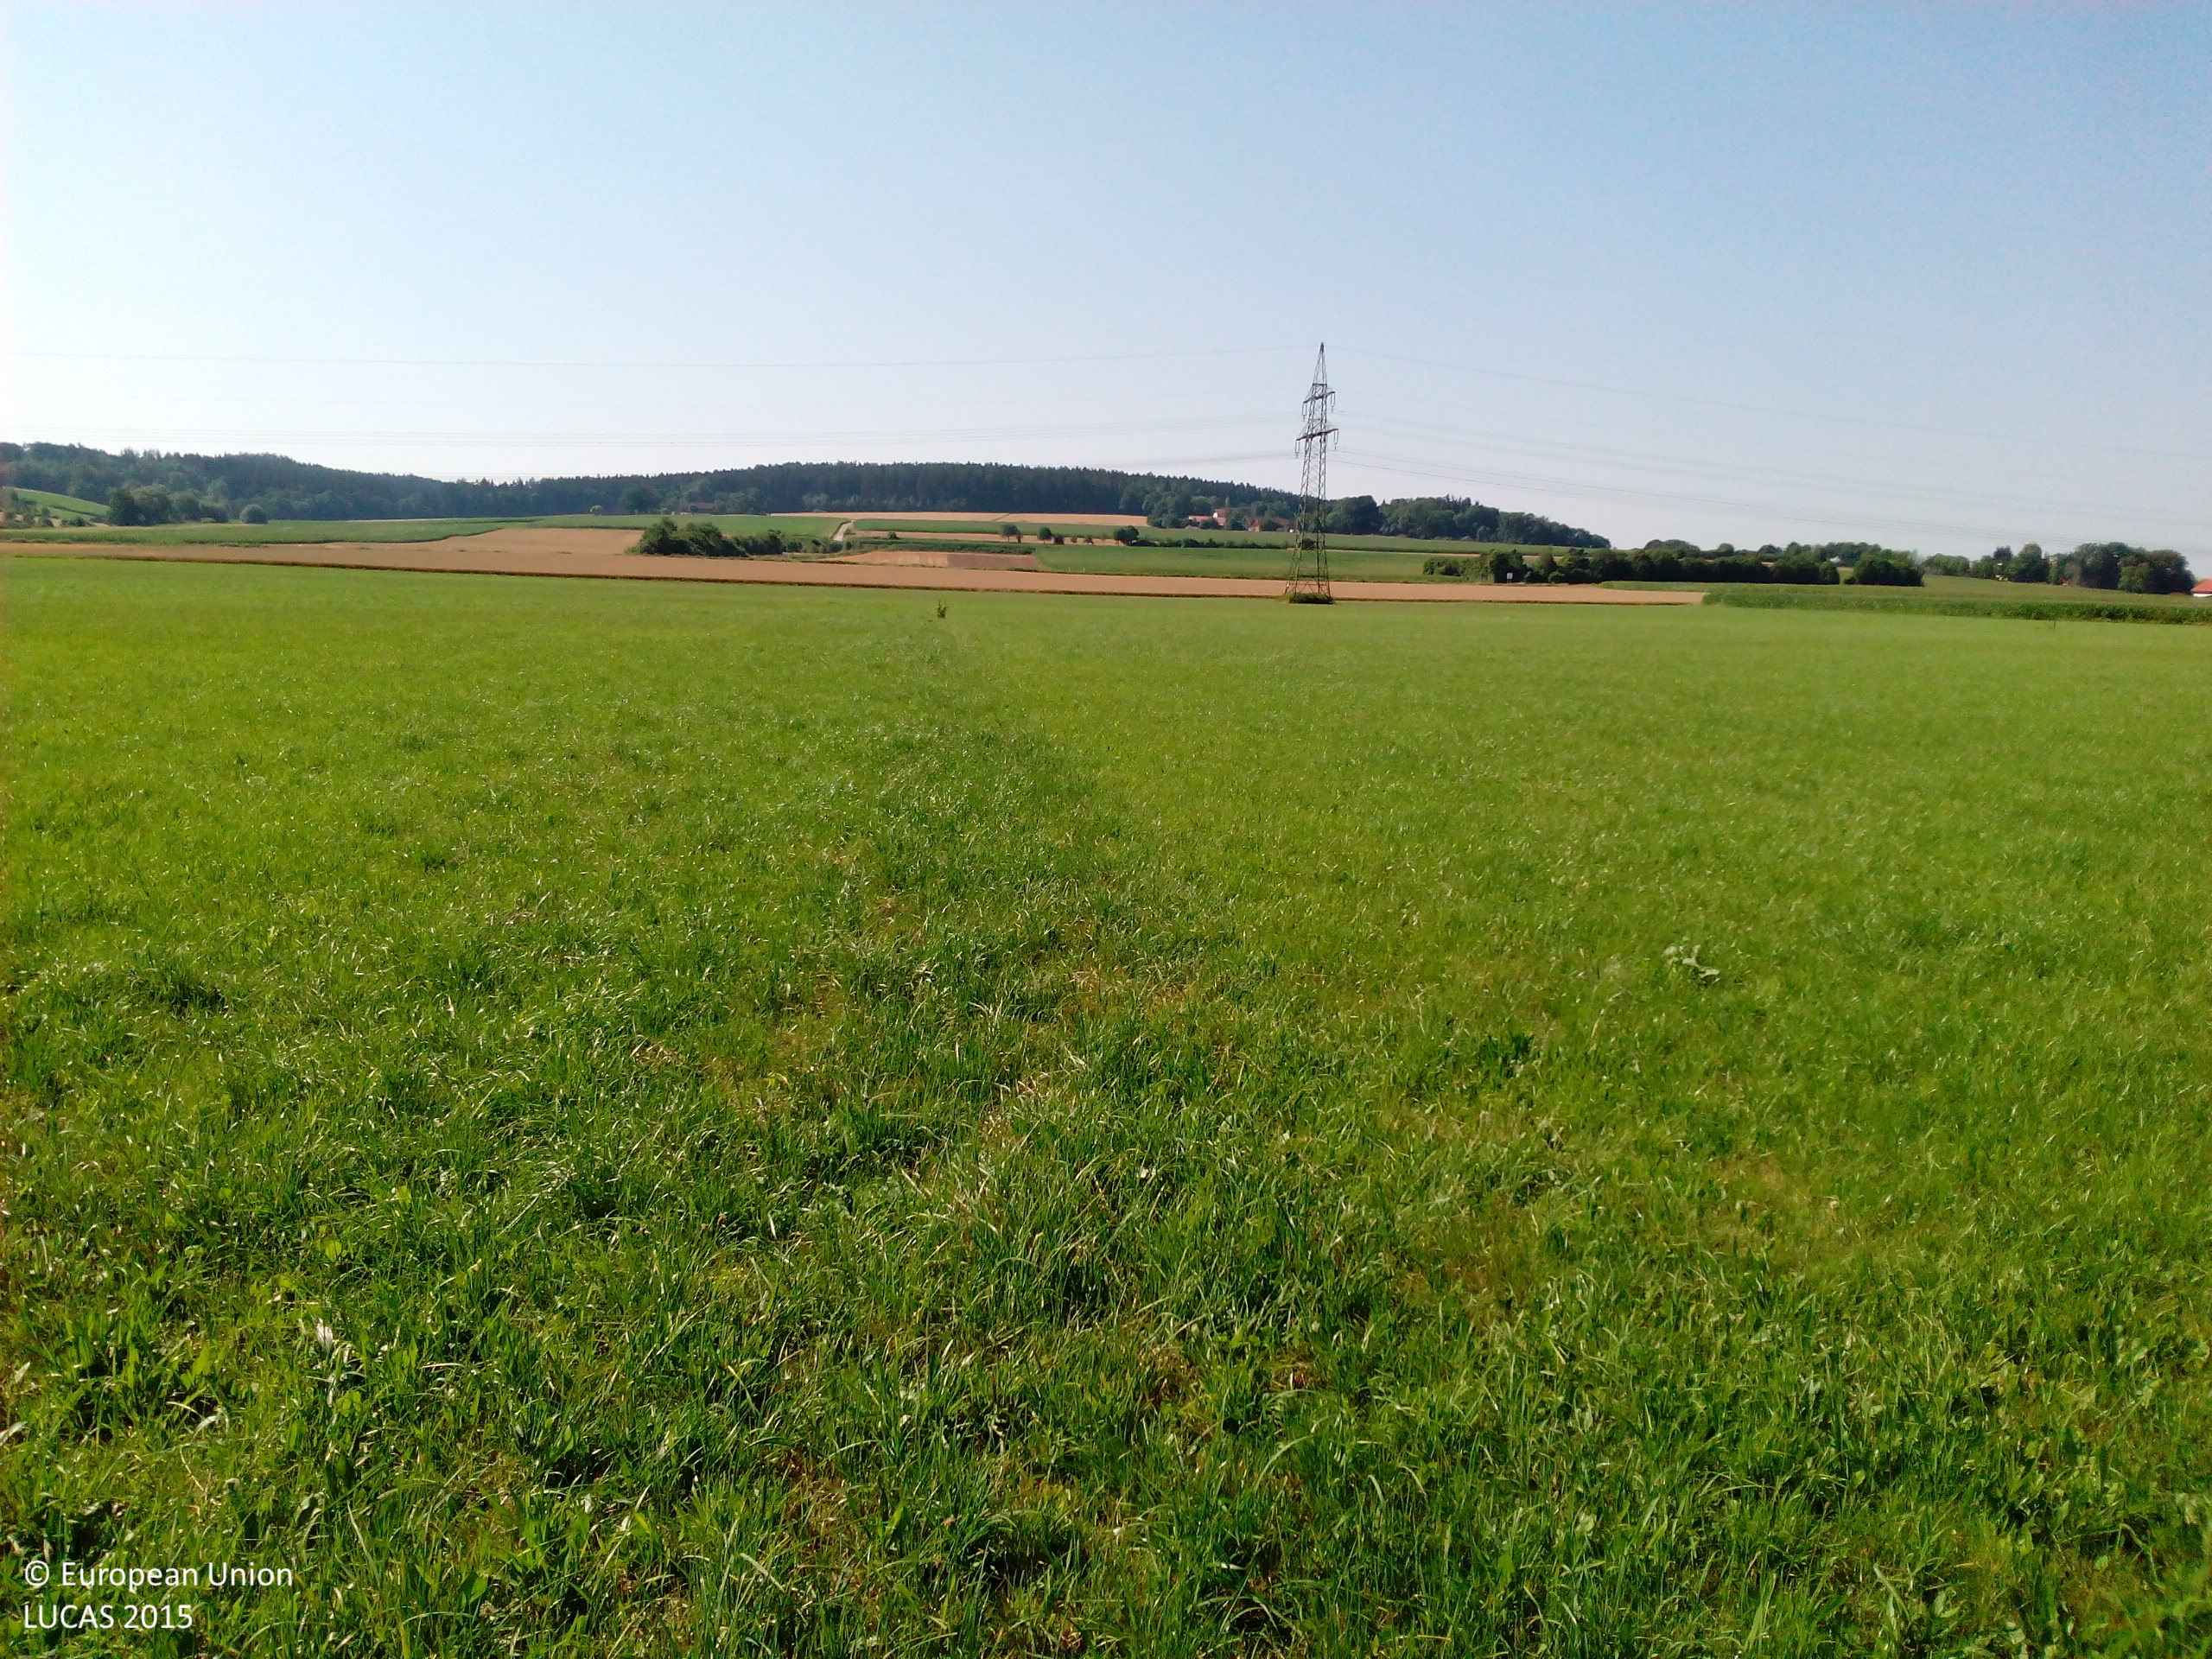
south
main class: Grassland
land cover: Grassland without tree/shrub cover
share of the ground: > 75 %
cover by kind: herbaceous plants 100 %
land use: Agriculture (excluding fallow land and kitchen gardens)
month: July
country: DE
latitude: 48.5992
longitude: 12.9147
